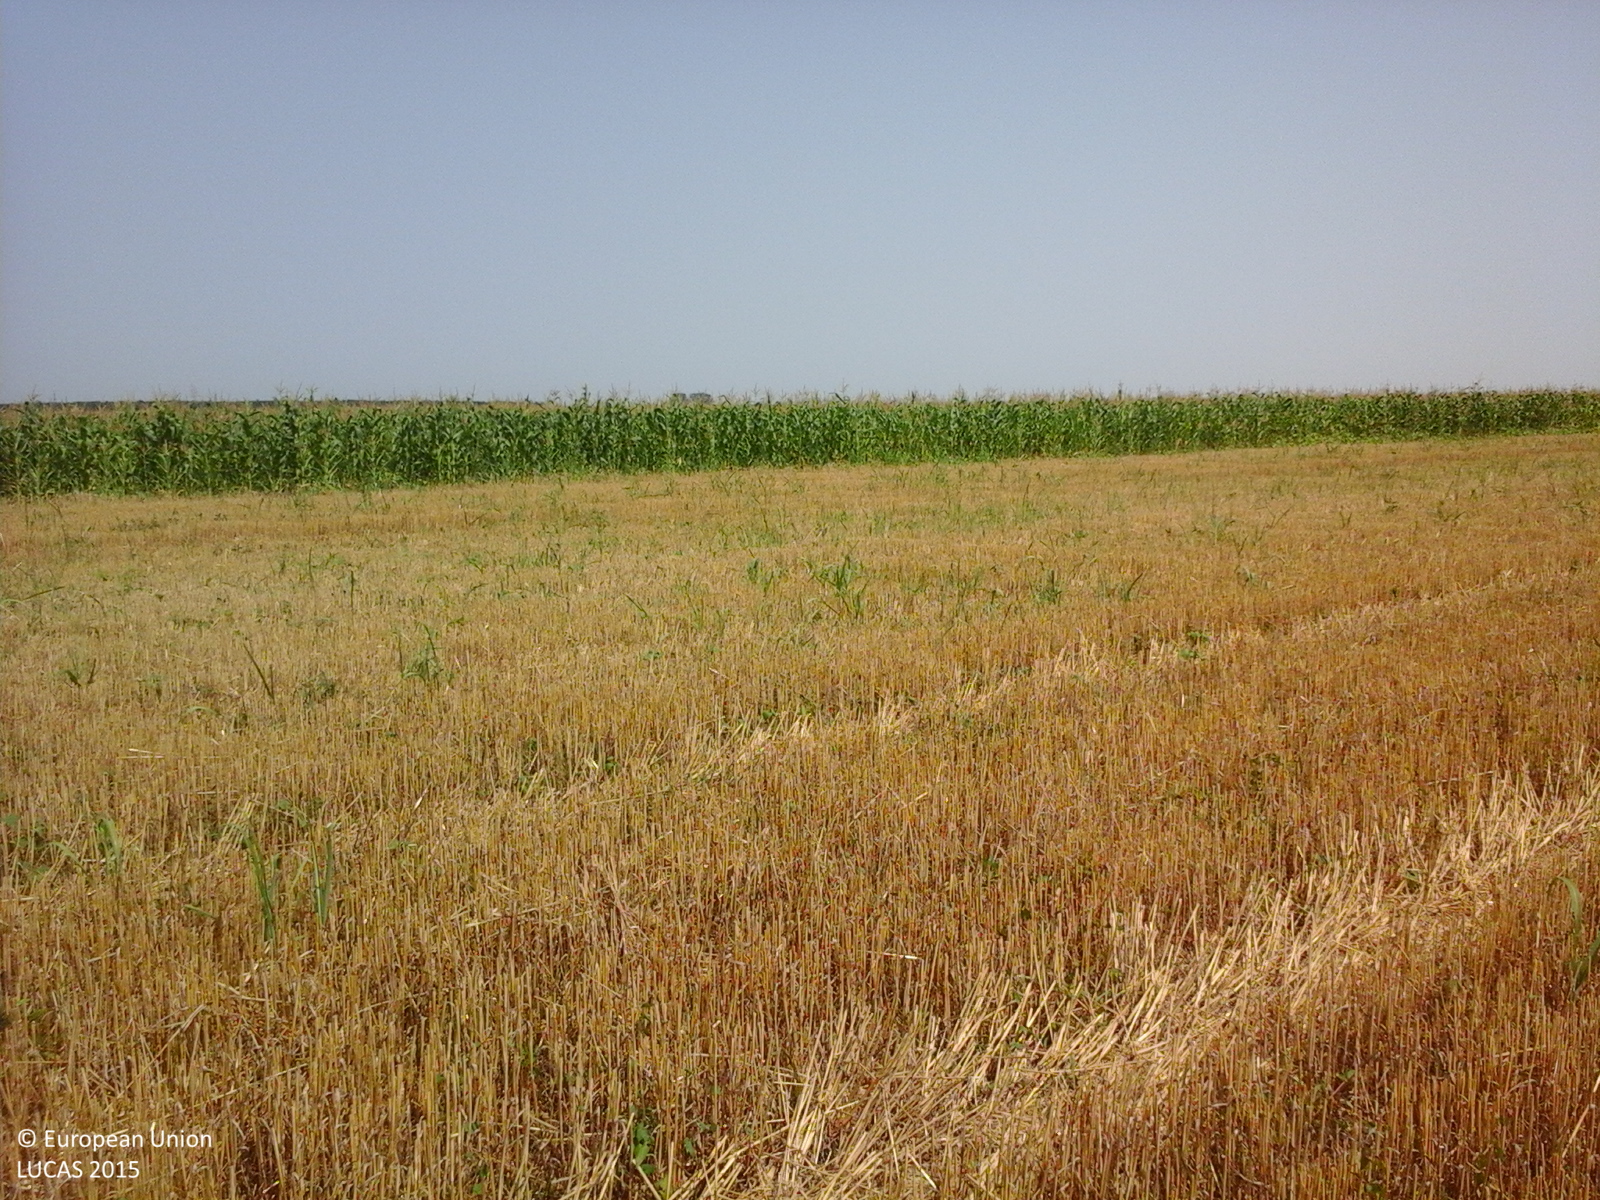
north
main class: Cropland
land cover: Durum wheat
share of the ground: 25 - 50 %
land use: Agriculture (excluding fallow land and kitchen gardens)
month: July
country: RO
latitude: 44.6331
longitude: 26.5175
